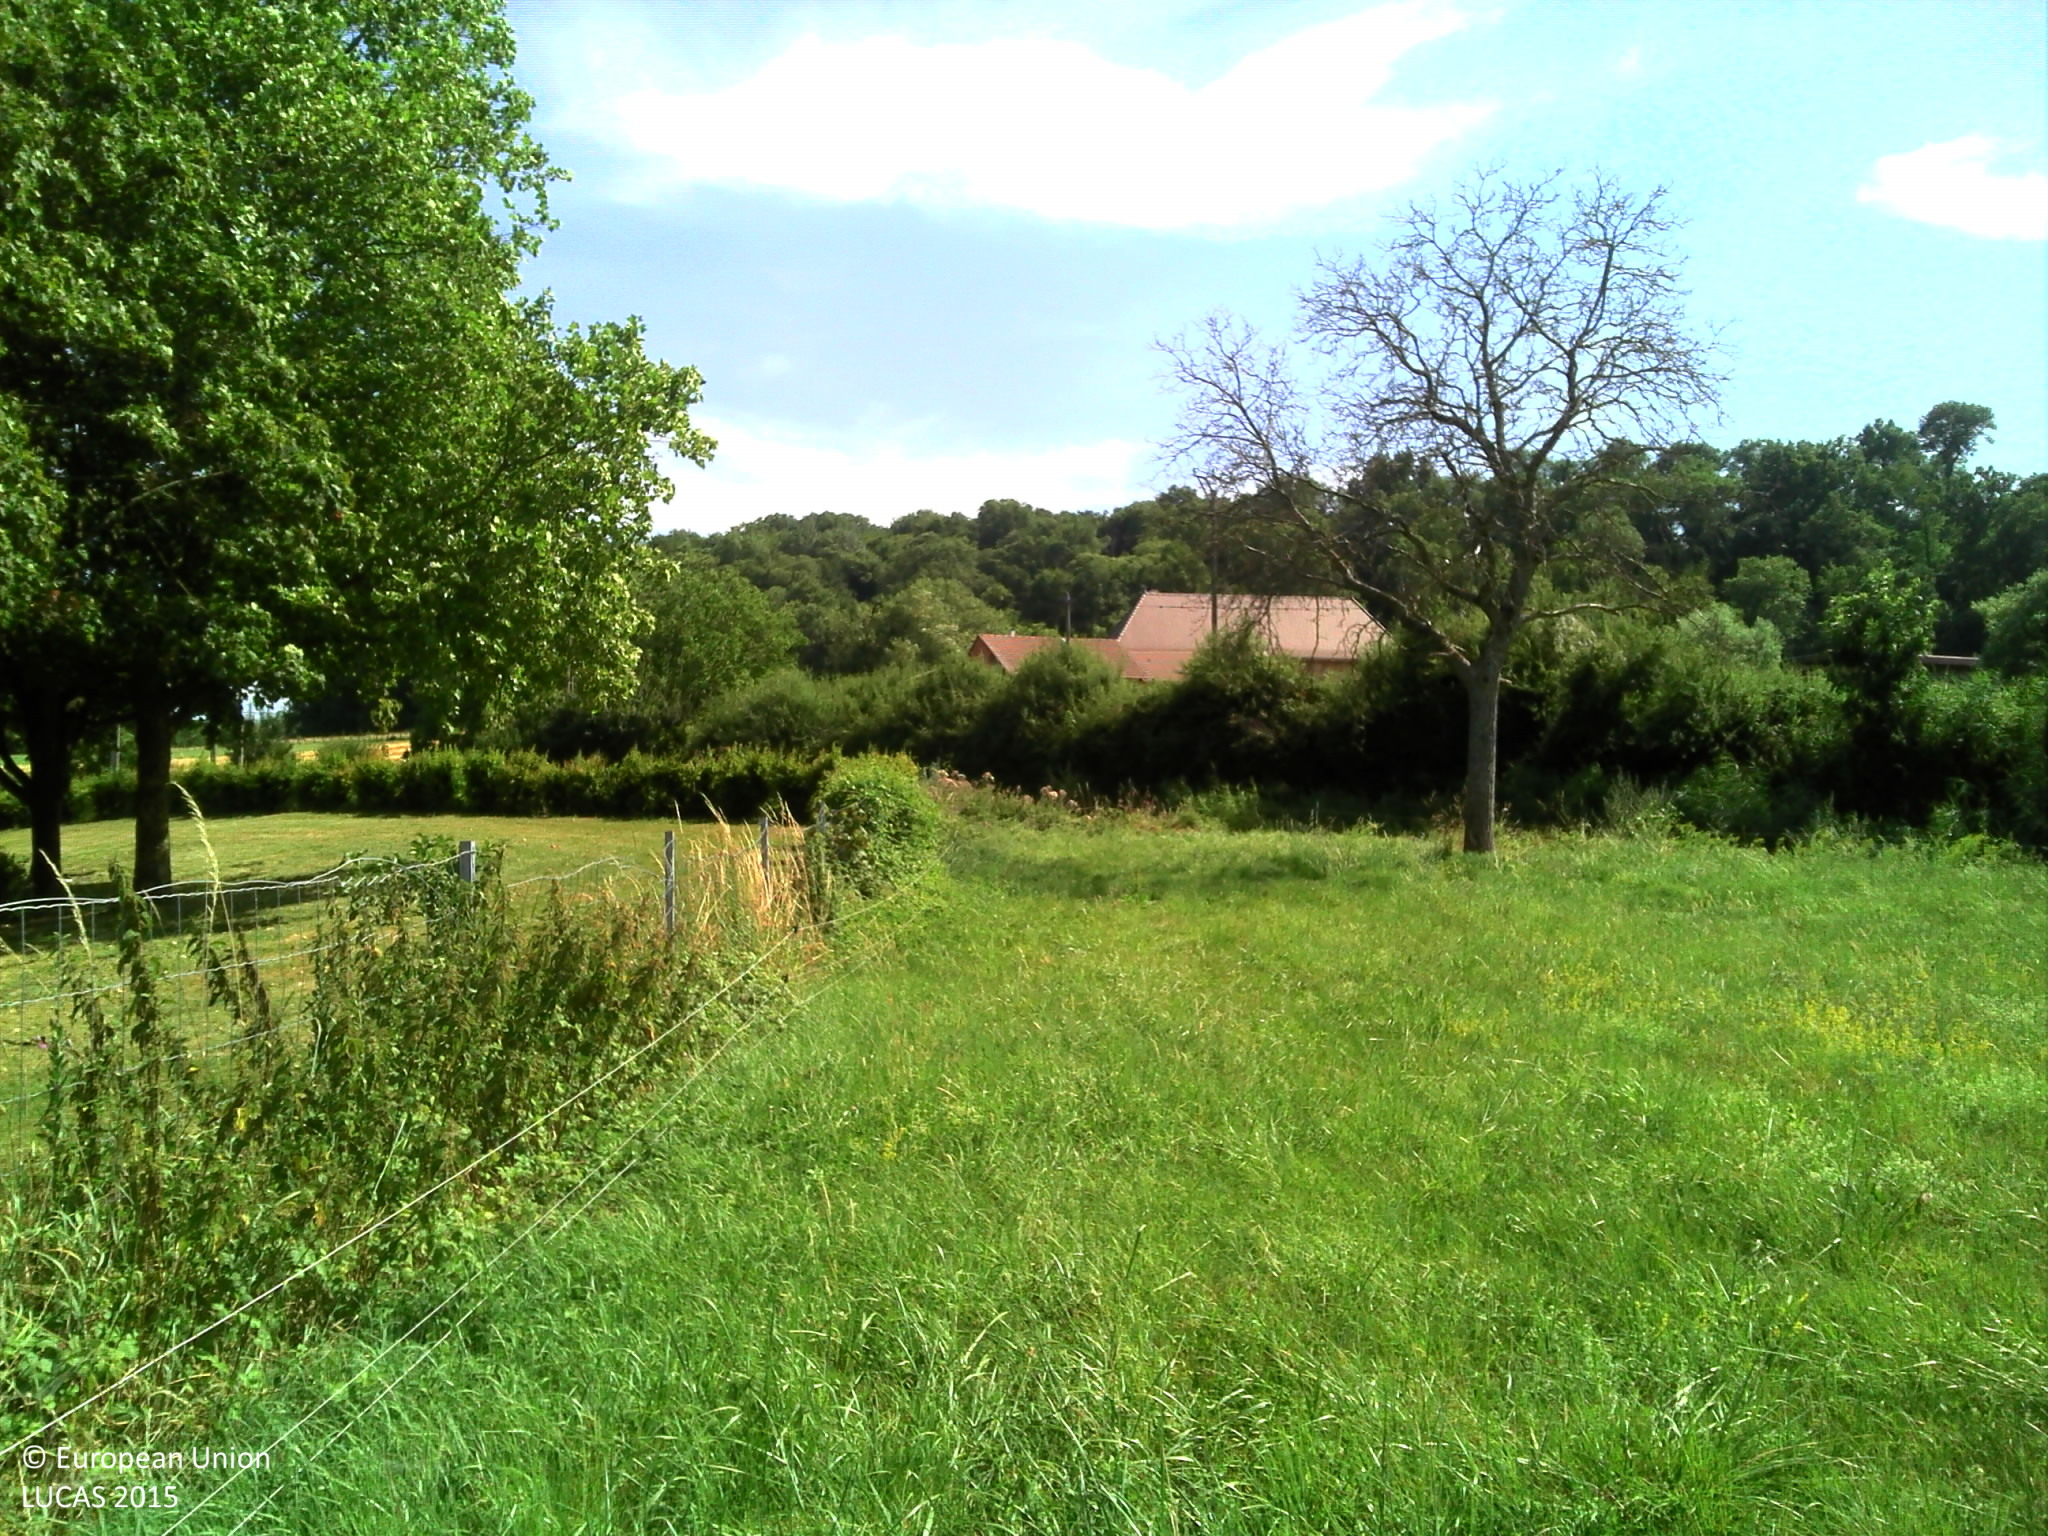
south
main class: Grassland
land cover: Grassland without tree/shrub cover
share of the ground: > 75 %
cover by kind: herbaceous plants 100 %
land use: Semi-natural and natural areas not in use
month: July
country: FR
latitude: 45.5309
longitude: 5.4077
